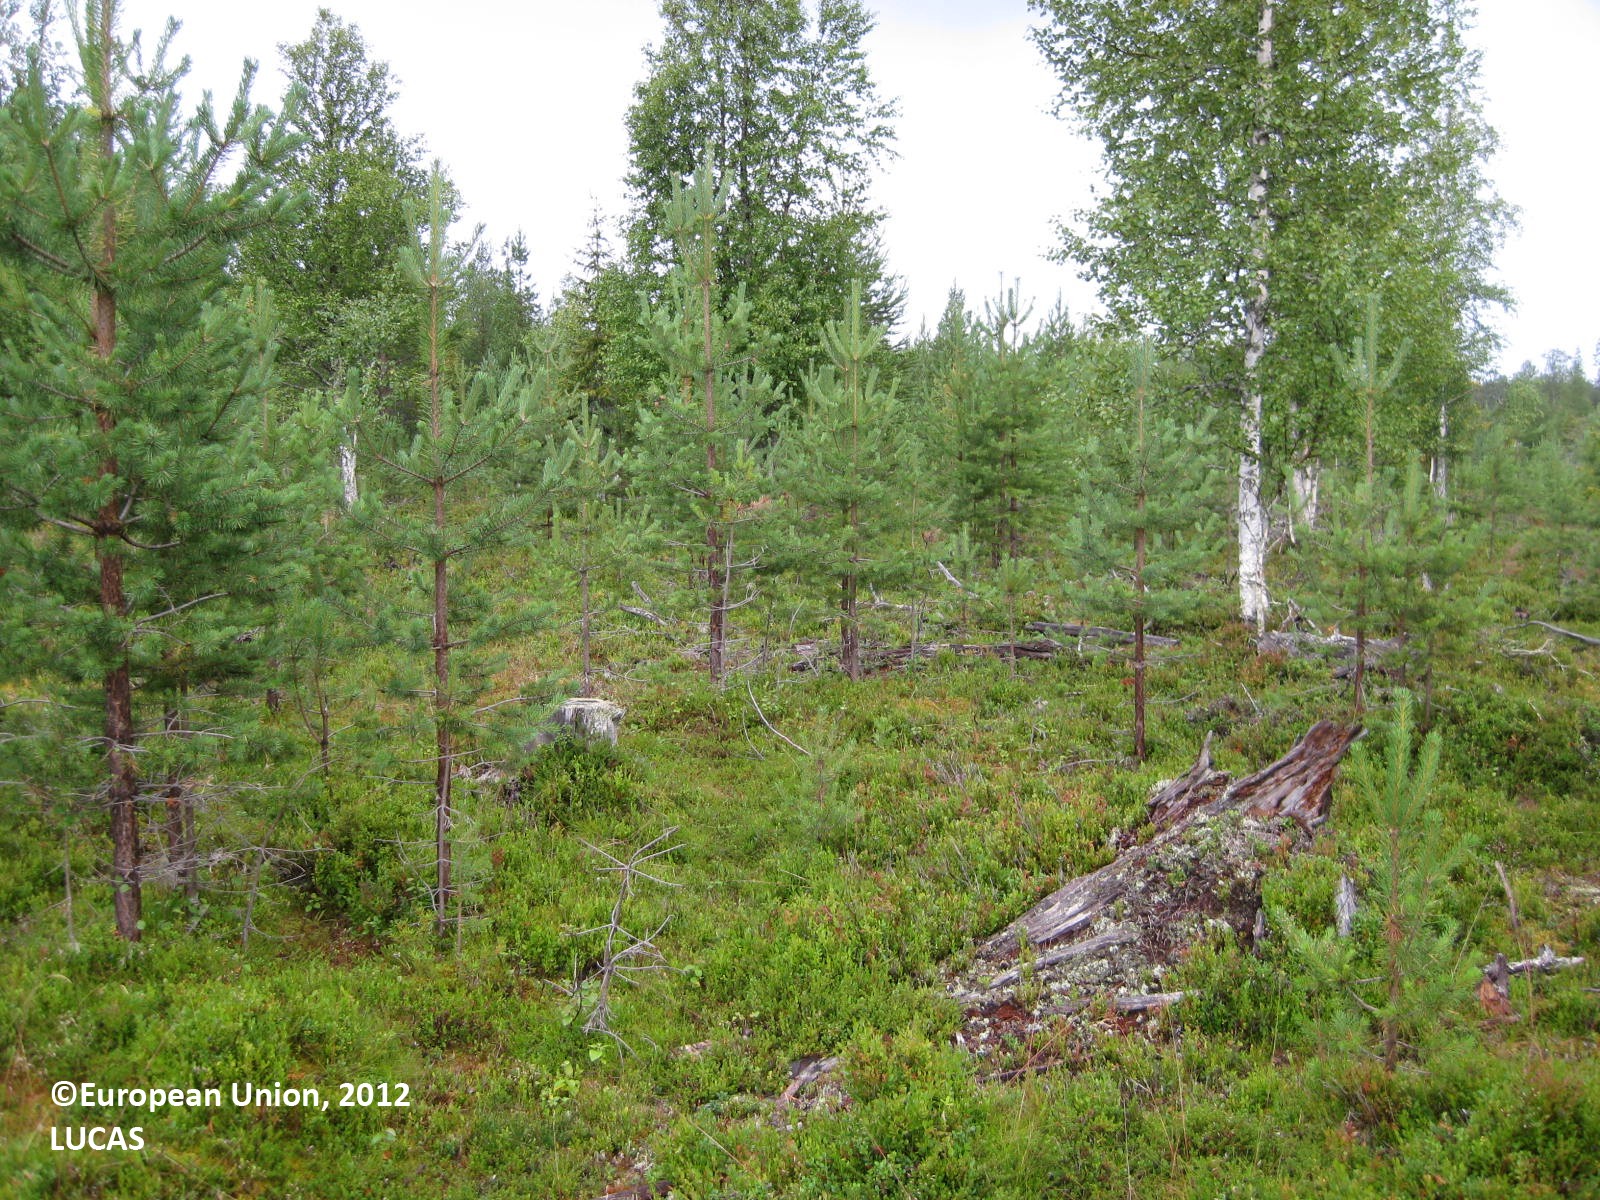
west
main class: Woodland
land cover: Pine dominated coniferous woodland
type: boreal forest
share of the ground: 50 - 75 %
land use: Forestry
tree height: < 5 m
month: August
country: FI
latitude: 66.0972
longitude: 28.3499
